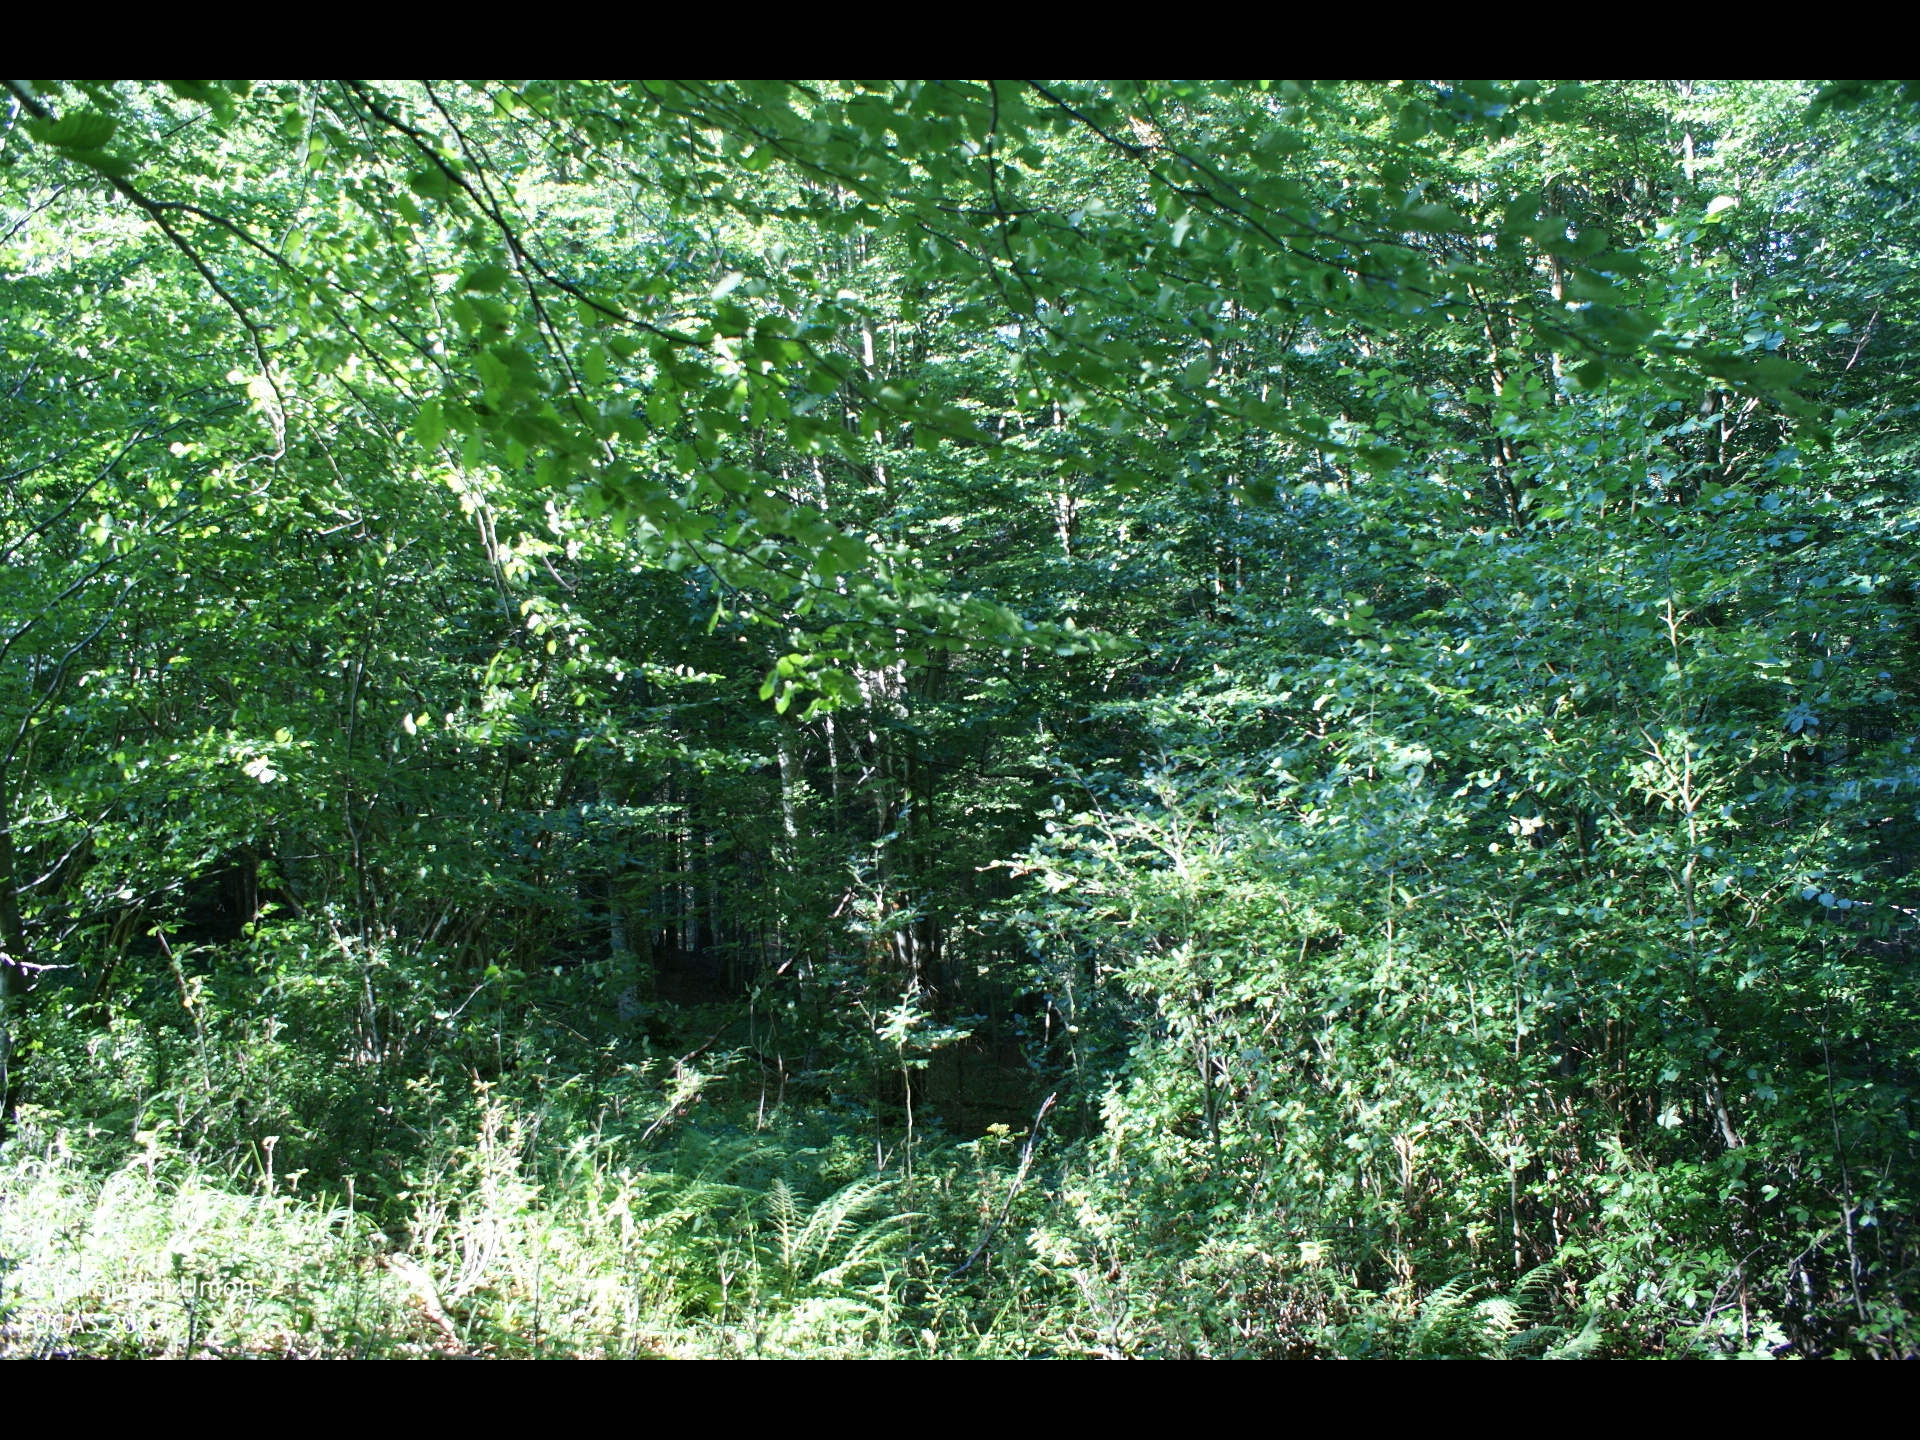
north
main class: Woodland
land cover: Broadleaved woodland
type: mountainous beech forest
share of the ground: > 75 %
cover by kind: broadleaved forest trees 75 %, coniferous forest trees 15 %, herbaceous plants 10 %
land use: Forestry
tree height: > 5 m
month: July
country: AT
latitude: 47.8930
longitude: 15.0163
